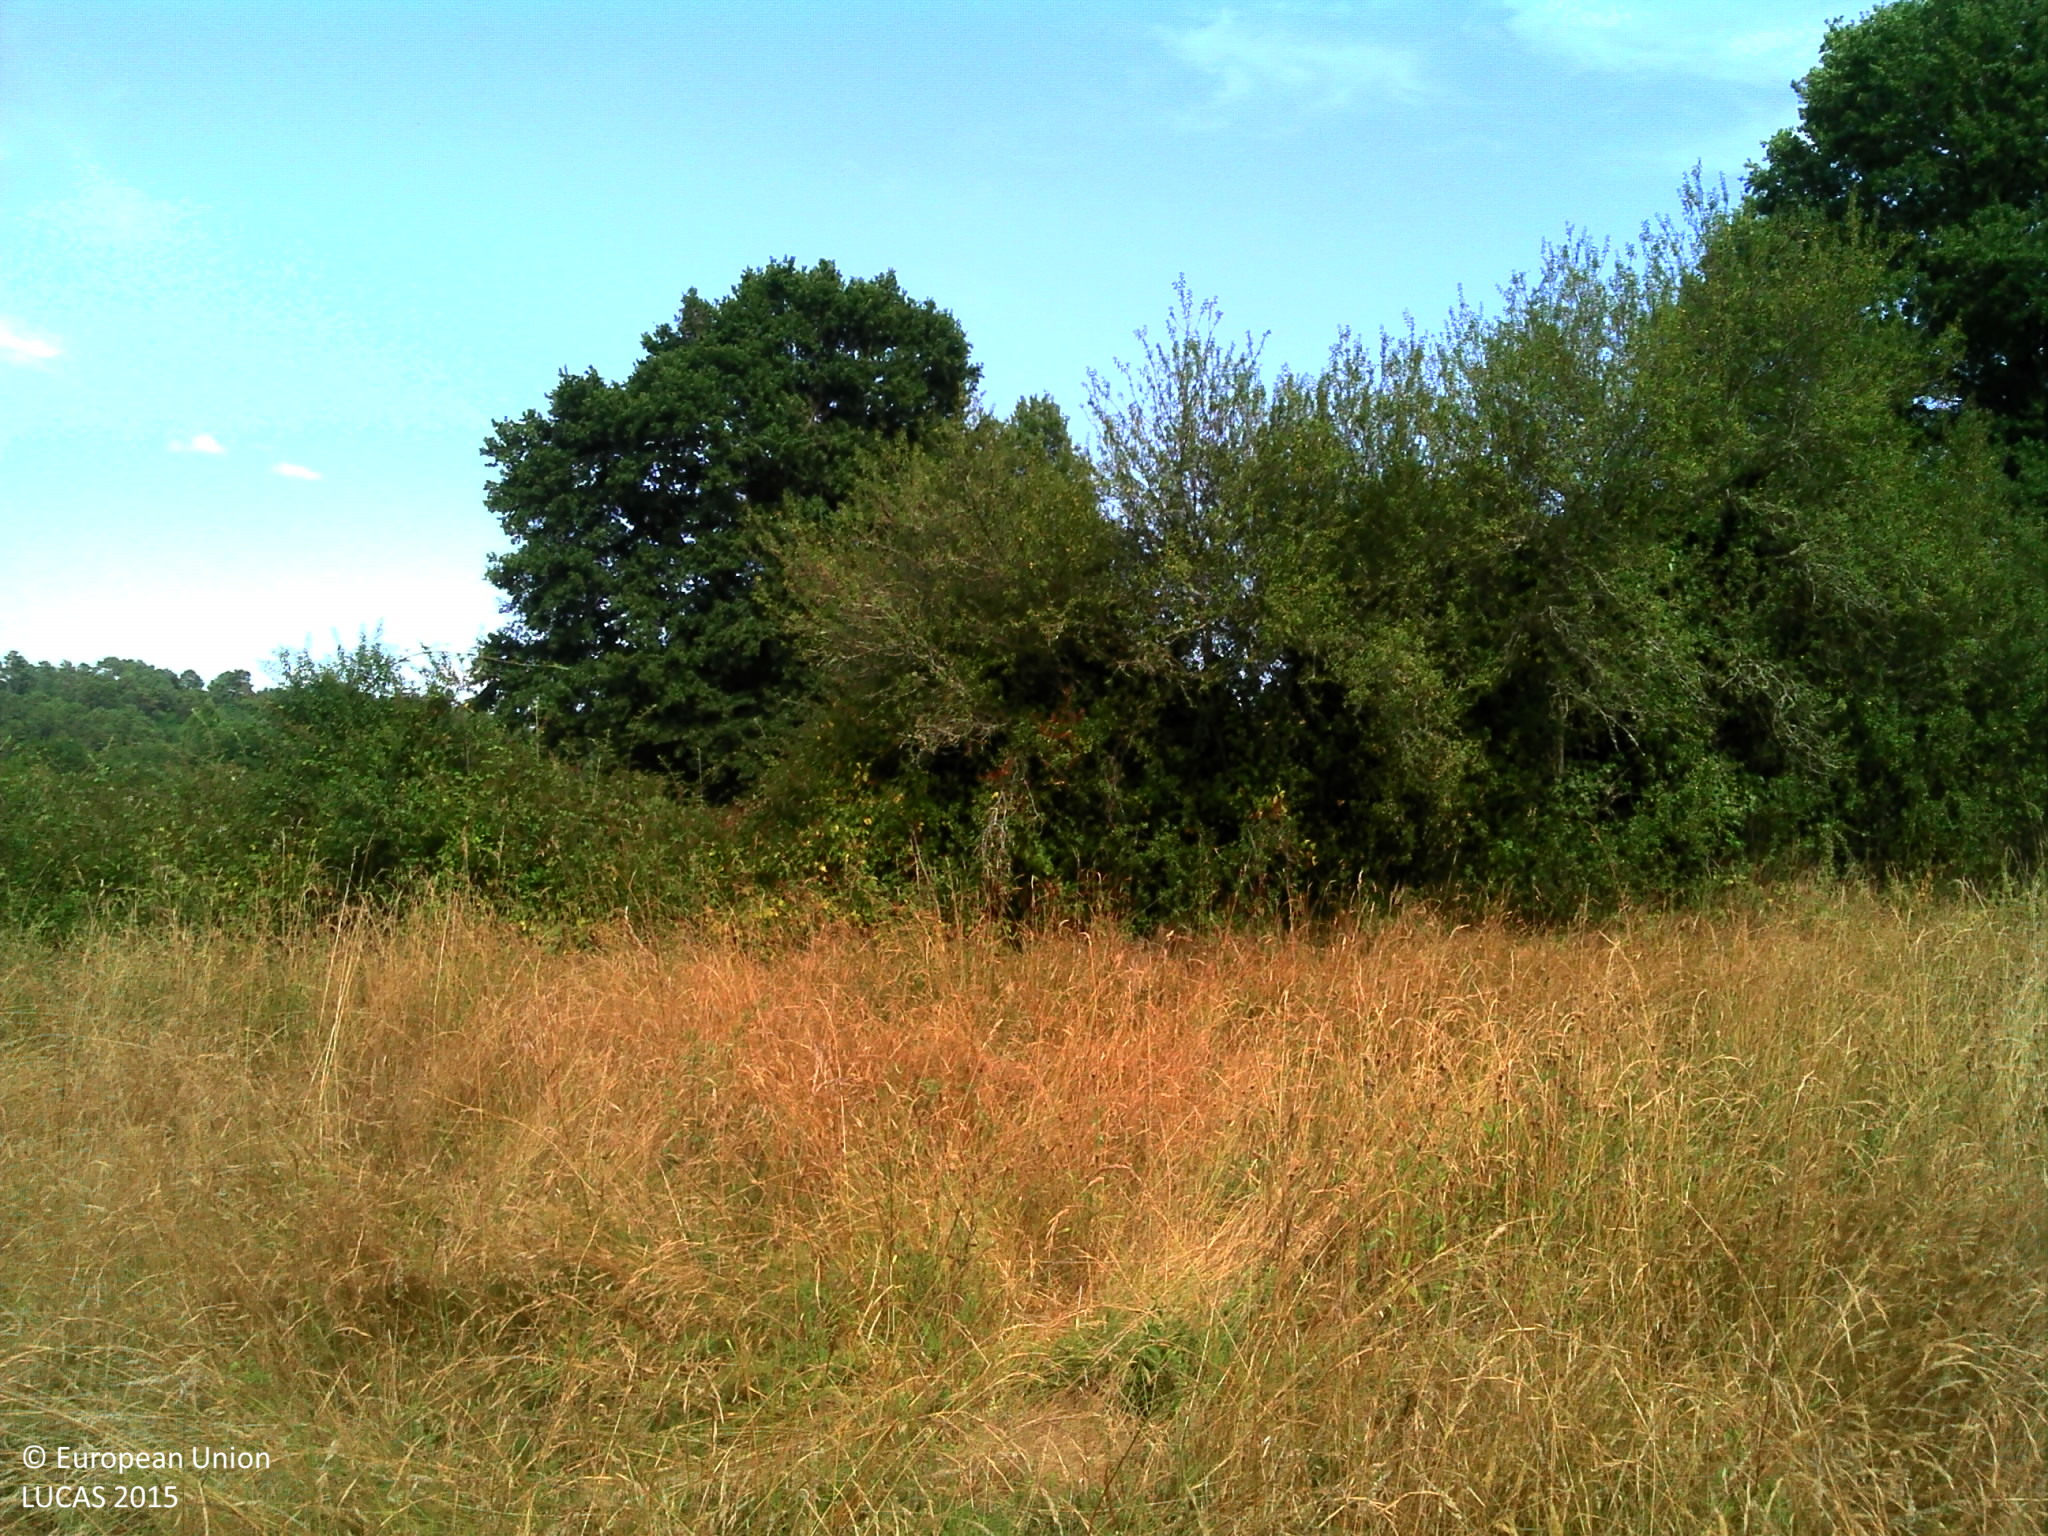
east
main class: Grassland
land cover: Grassland without tree/shrub cover
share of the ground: > 75 %
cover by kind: herbaceous plants 90 %, shrubs 5 %, unconsolidated bare surface 5 %
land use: Agriculture (excluding fallow land and kitchen gardens)
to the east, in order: Grassland without tree/shrub cover; Managed hedges; Spontaneously vegetated surfaces; Fences; Grassland with sparse tree/shrub cover; Fences; Managed hedges; Durum wheat
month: July
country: FR
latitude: 45.0619
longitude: 0.5538
